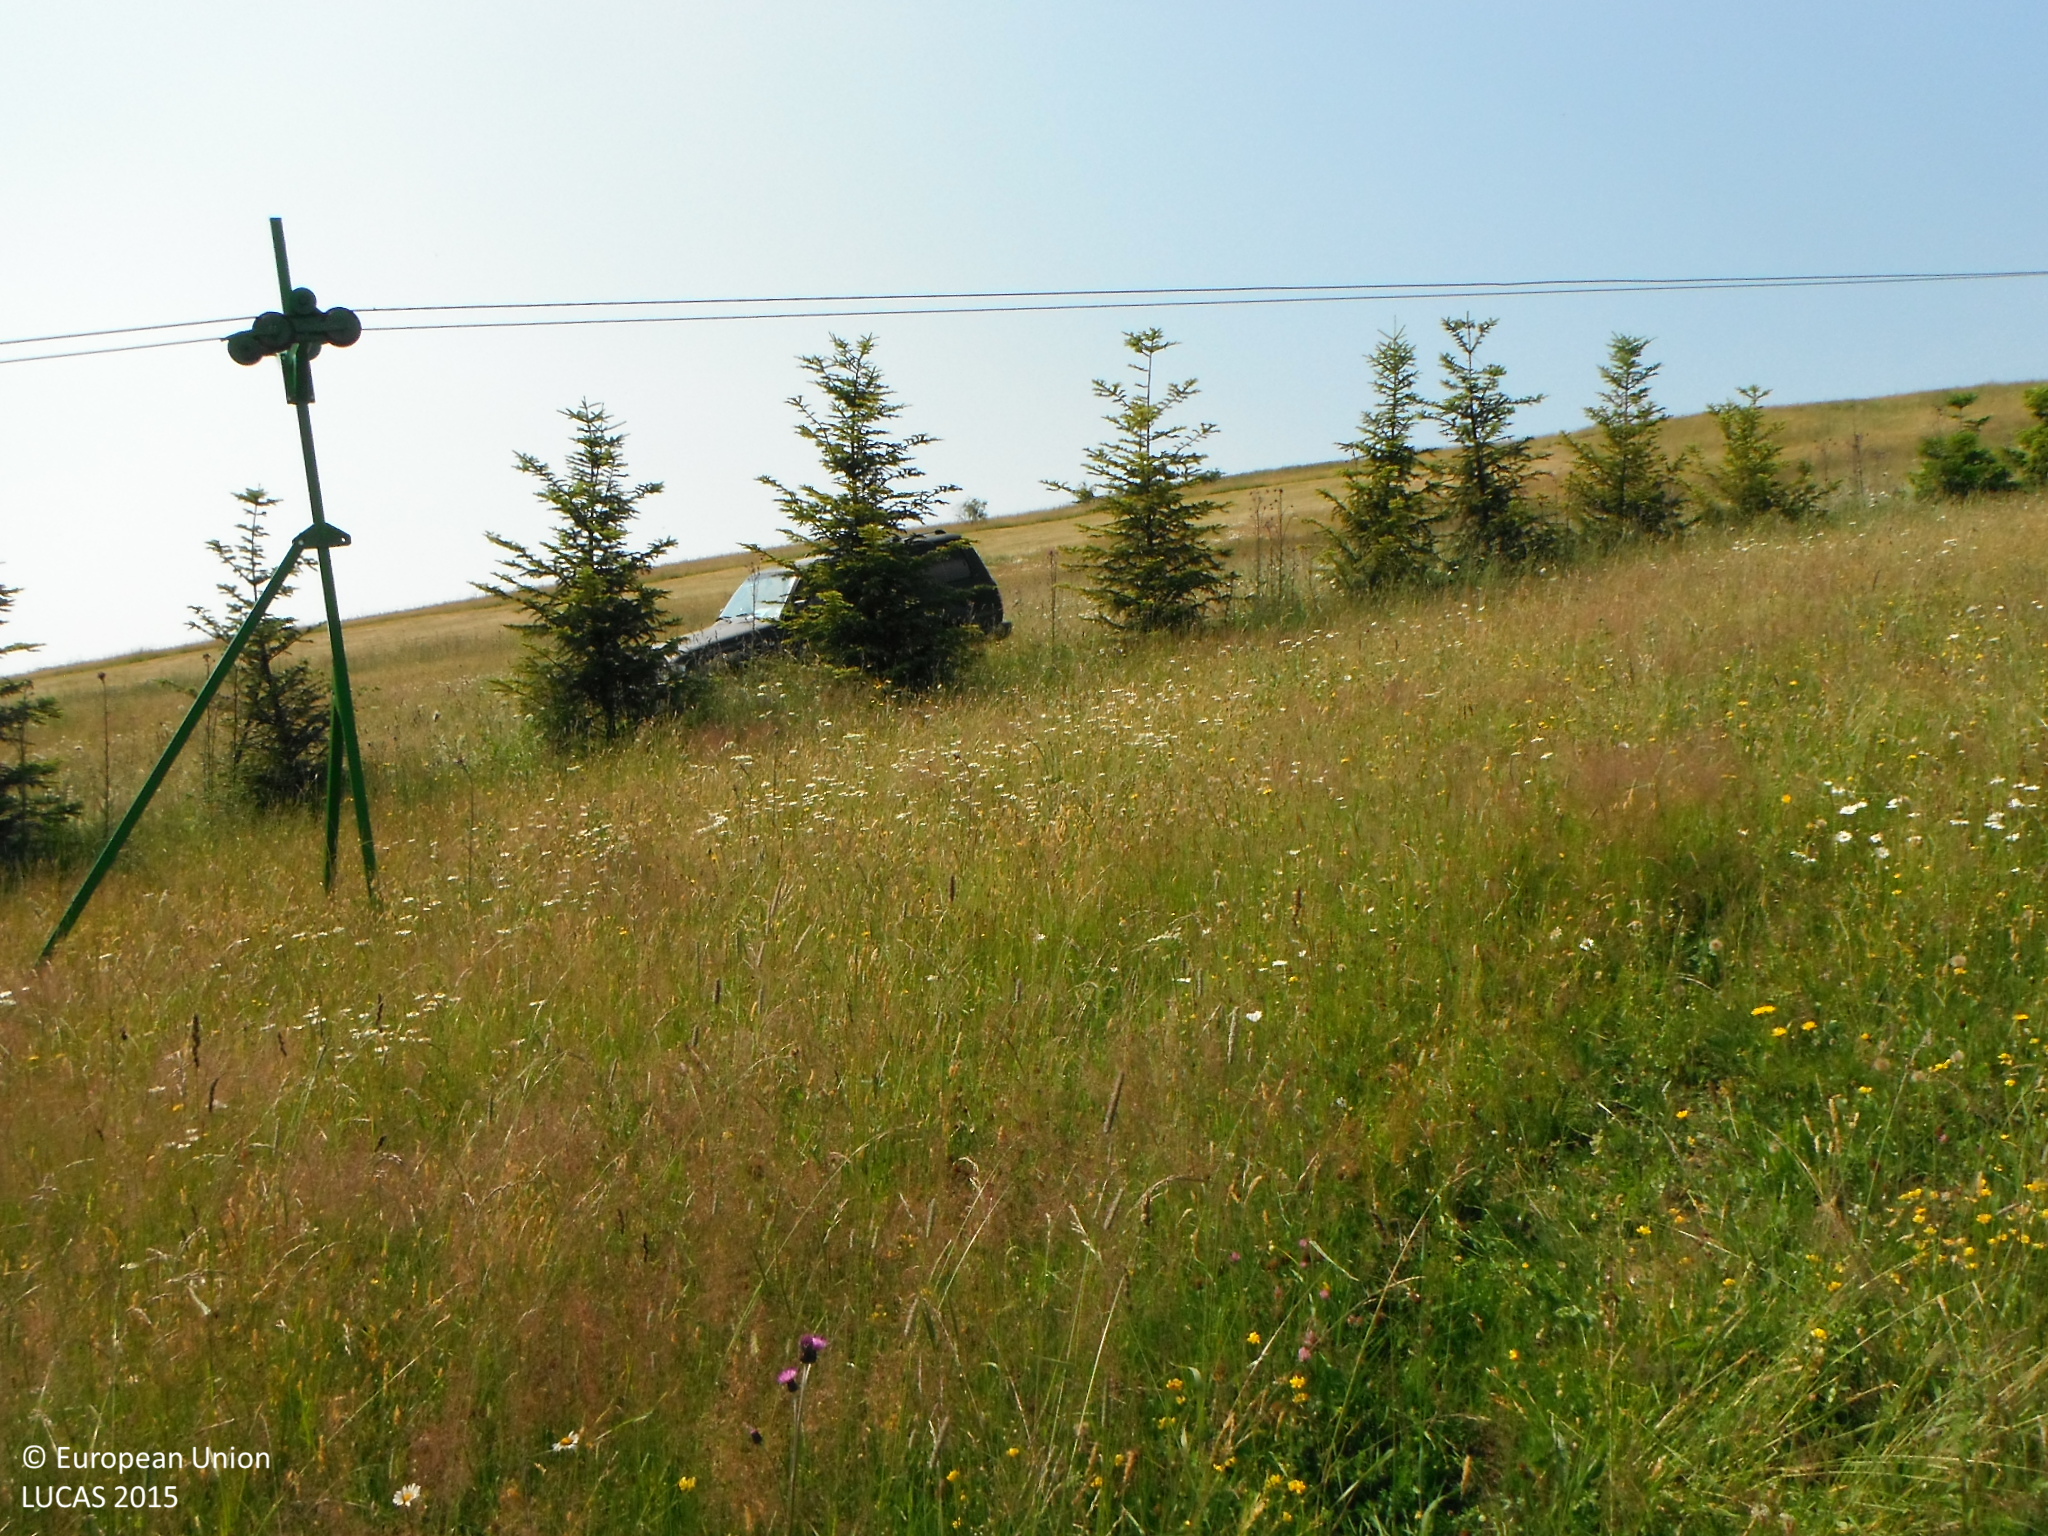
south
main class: Grassland
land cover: Grassland without tree/shrub cover
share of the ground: > 75 %
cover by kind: herbaceous plants 100 %
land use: Agriculture (excluding fallow land and kitchen gardens)
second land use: Sport
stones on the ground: < 10 %
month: July
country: SK
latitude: 49.5207
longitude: 19.4333
